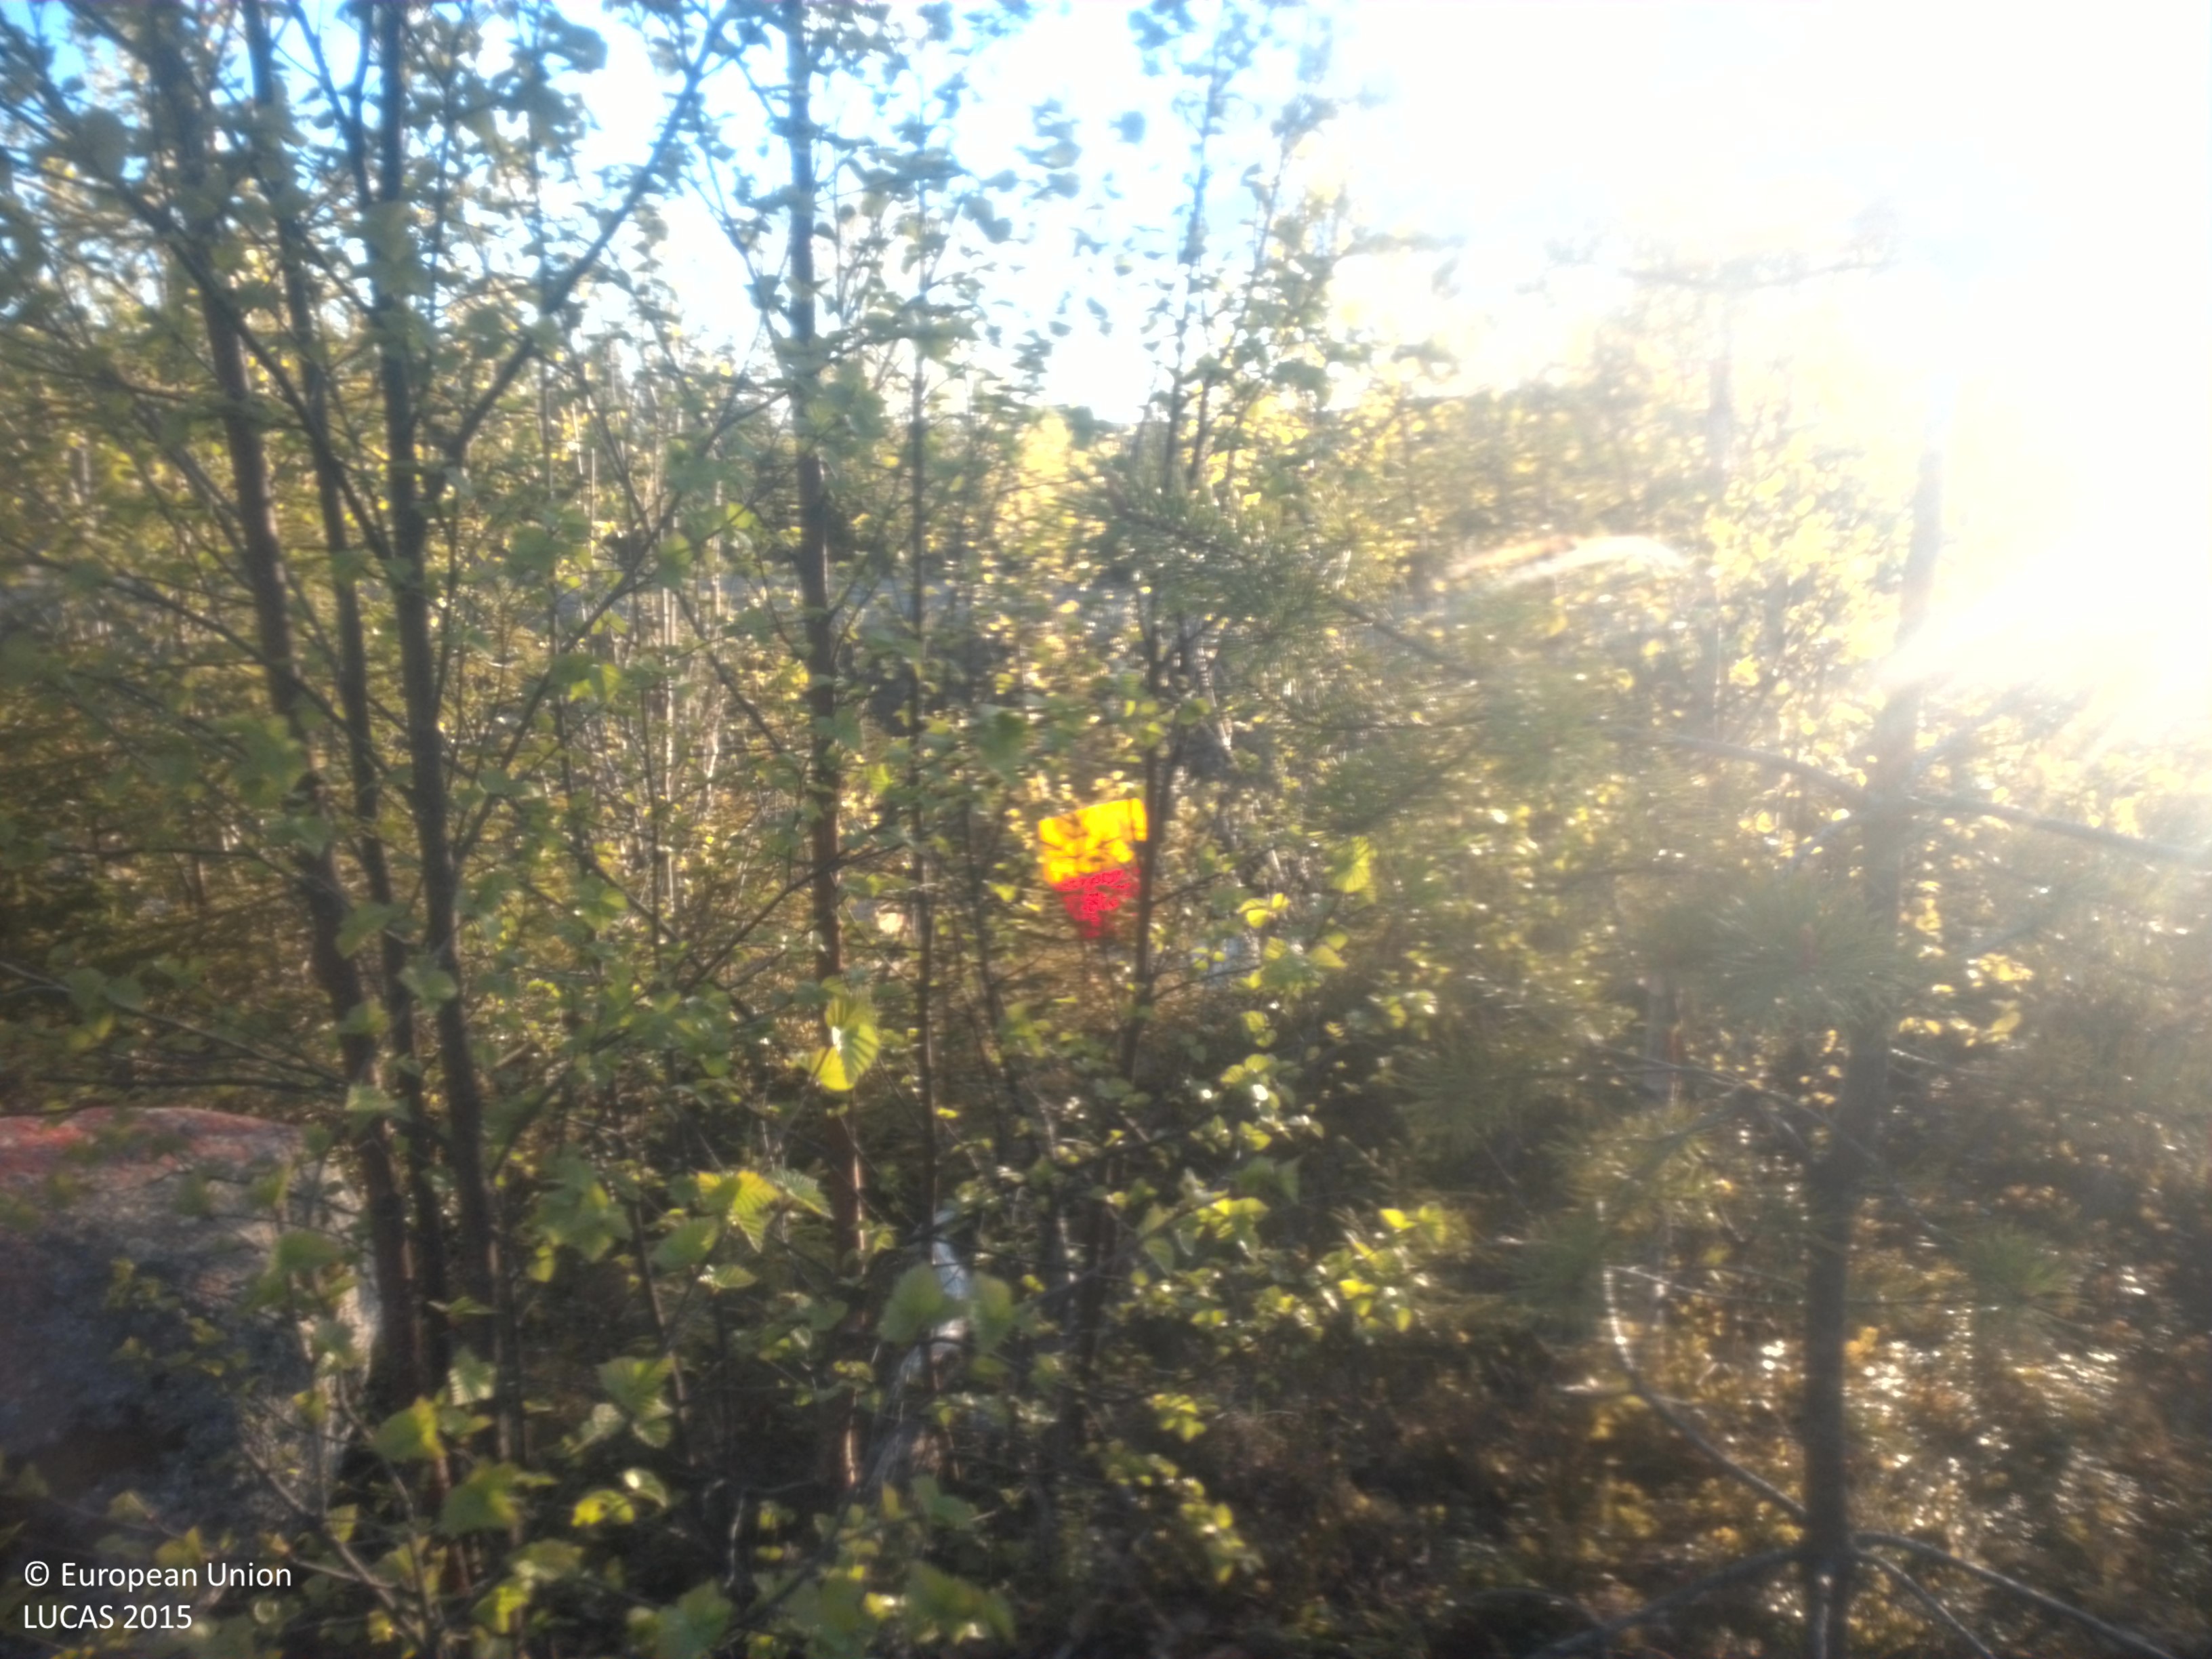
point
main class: Woodland
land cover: Broadleaved woodland
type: boreal forest
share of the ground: 25 - 50 %
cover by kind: broadleaved forest trees 35 %, herbaceous plants 20 %, lichens and mosses 20 %, shrubs 10 %, coniferous forest trees 5 %, unconsolidated bare surface 5 %
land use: Forestry
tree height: < 5 m
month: June
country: SE
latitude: 64.4144
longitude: 17.6259
